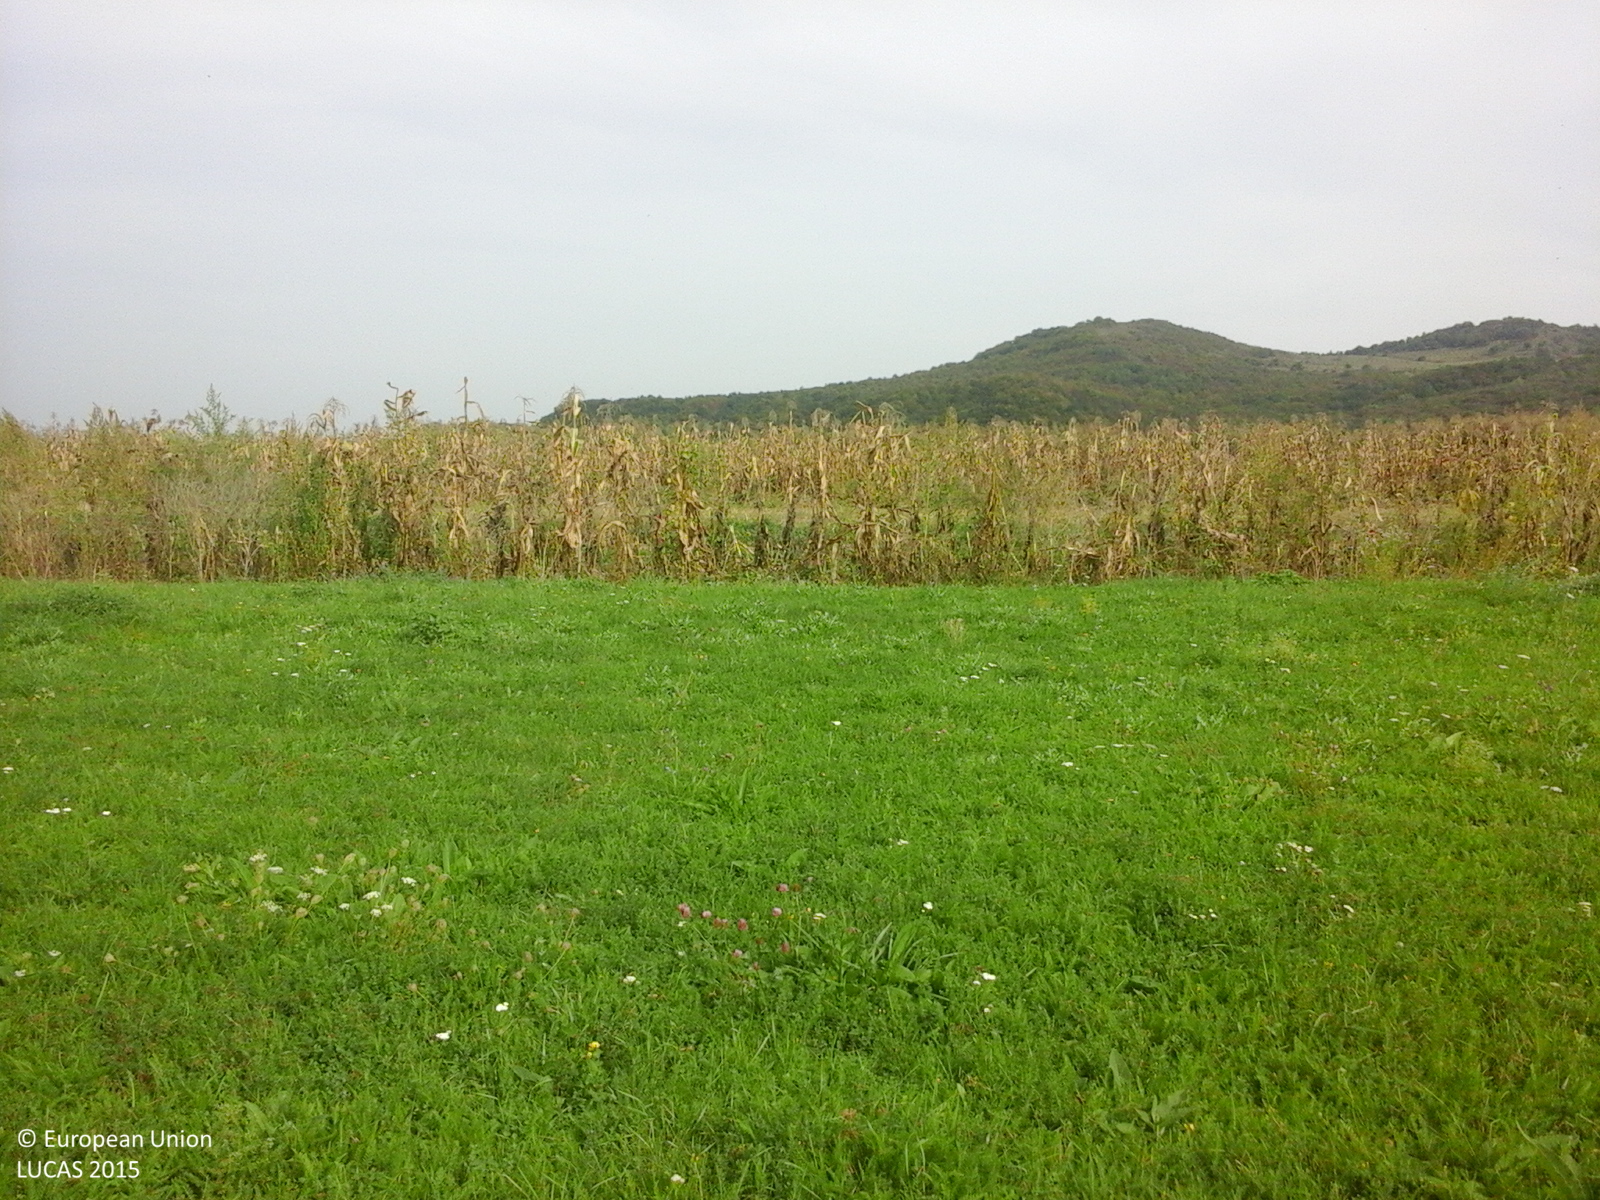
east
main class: Grassland
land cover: Grassland without tree/shrub cover
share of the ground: > 75 %
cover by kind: herbaceous plants 100 %
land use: Agriculture (excluding fallow land and kitchen gardens)
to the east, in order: Grassland without tree/shrub cover; Potatoes; Maize; Spontaneously vegetated surfaces; Ditches and canals; Spontaneously vegetated surfaces; Tracks; Spontaneously vegetated surfaces; Lucerne; Maize; Sunflower; Maize
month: September
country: RO
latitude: 47.1606
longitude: 23.9972
